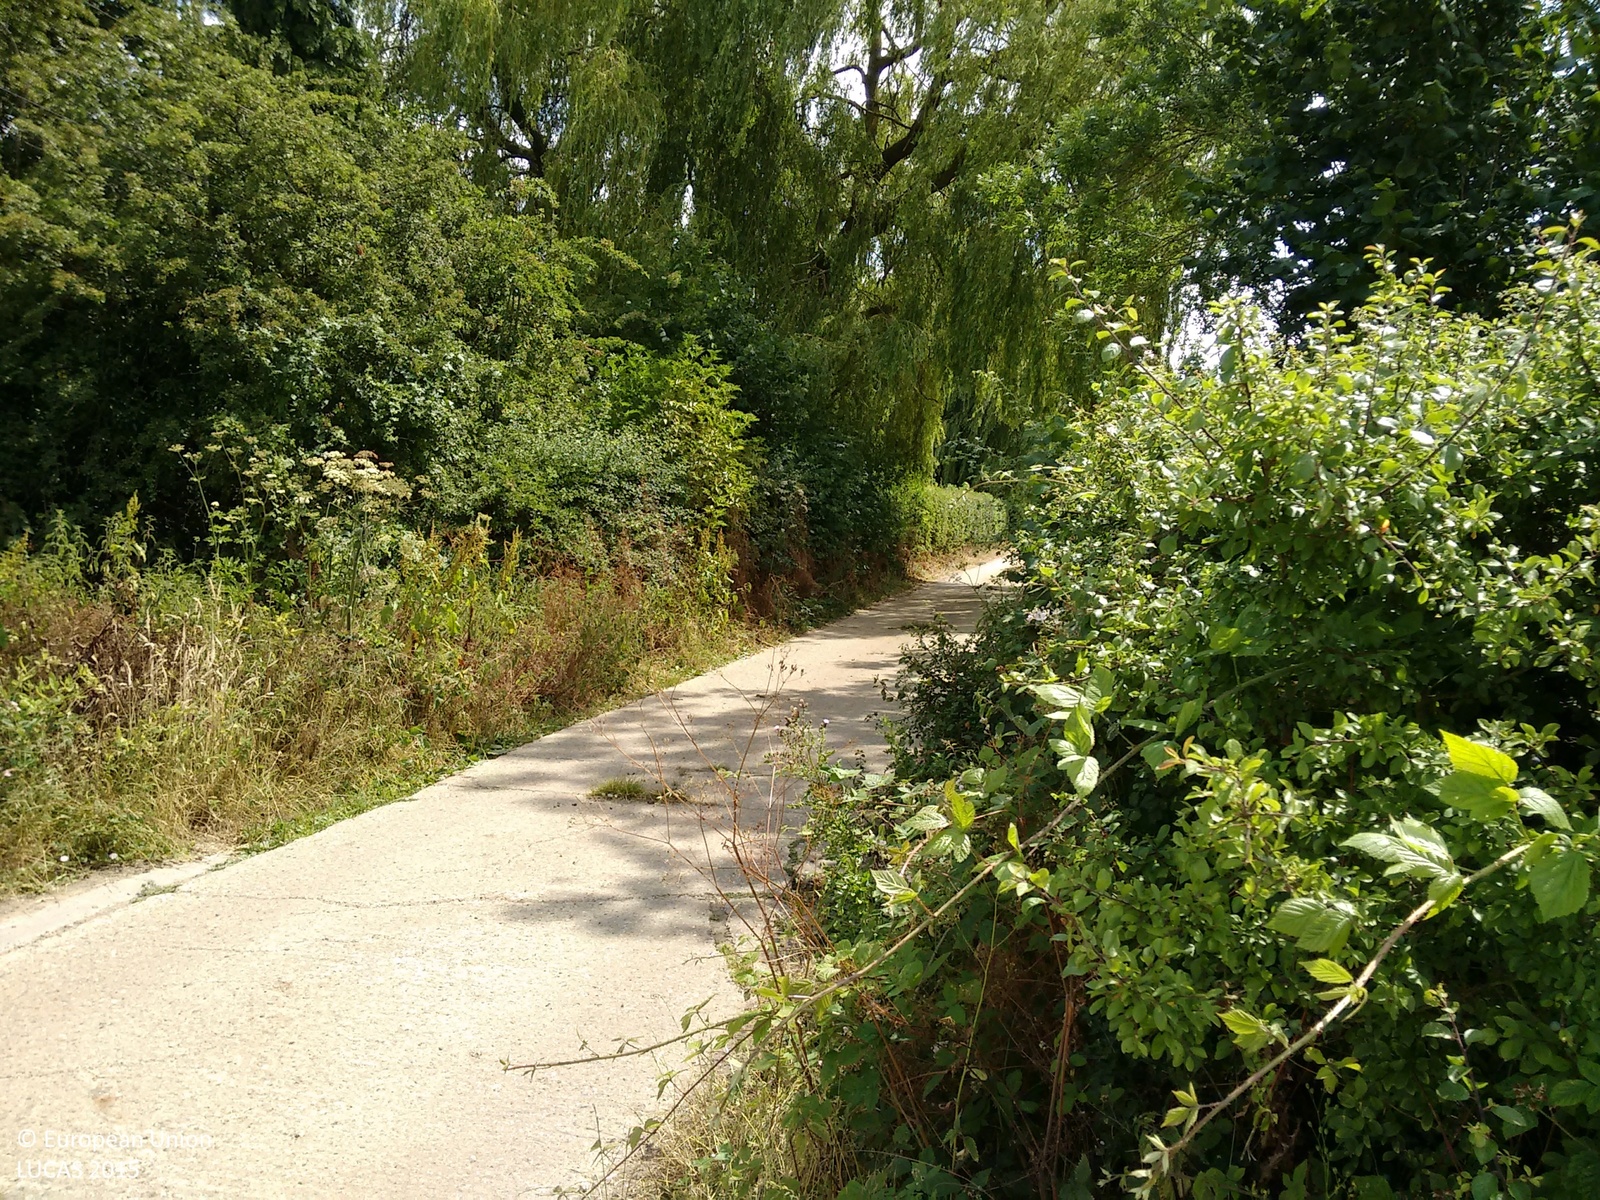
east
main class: Grassland
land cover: Grassland without tree/shrub cover
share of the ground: > 75 %
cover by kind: herbaceous plants 100 %
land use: Agriculture (excluding fallow land and kitchen gardens)
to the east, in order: Grassland without tree/shrub cover; Managed hedges; Grass margins; Paved roads, cycling and walking lanes; Grass margins; Managed hedges; Electric lines; Grassland without tree/shrub cover; Managed hedges; Artificial constructions in urban areas; Grassland with sparse tree/shrub cover; Grassland without tree/shrub cover; Fences; Grassland without tree/shrub cover
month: July
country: GB
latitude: 51.2768
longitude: -0.4887
